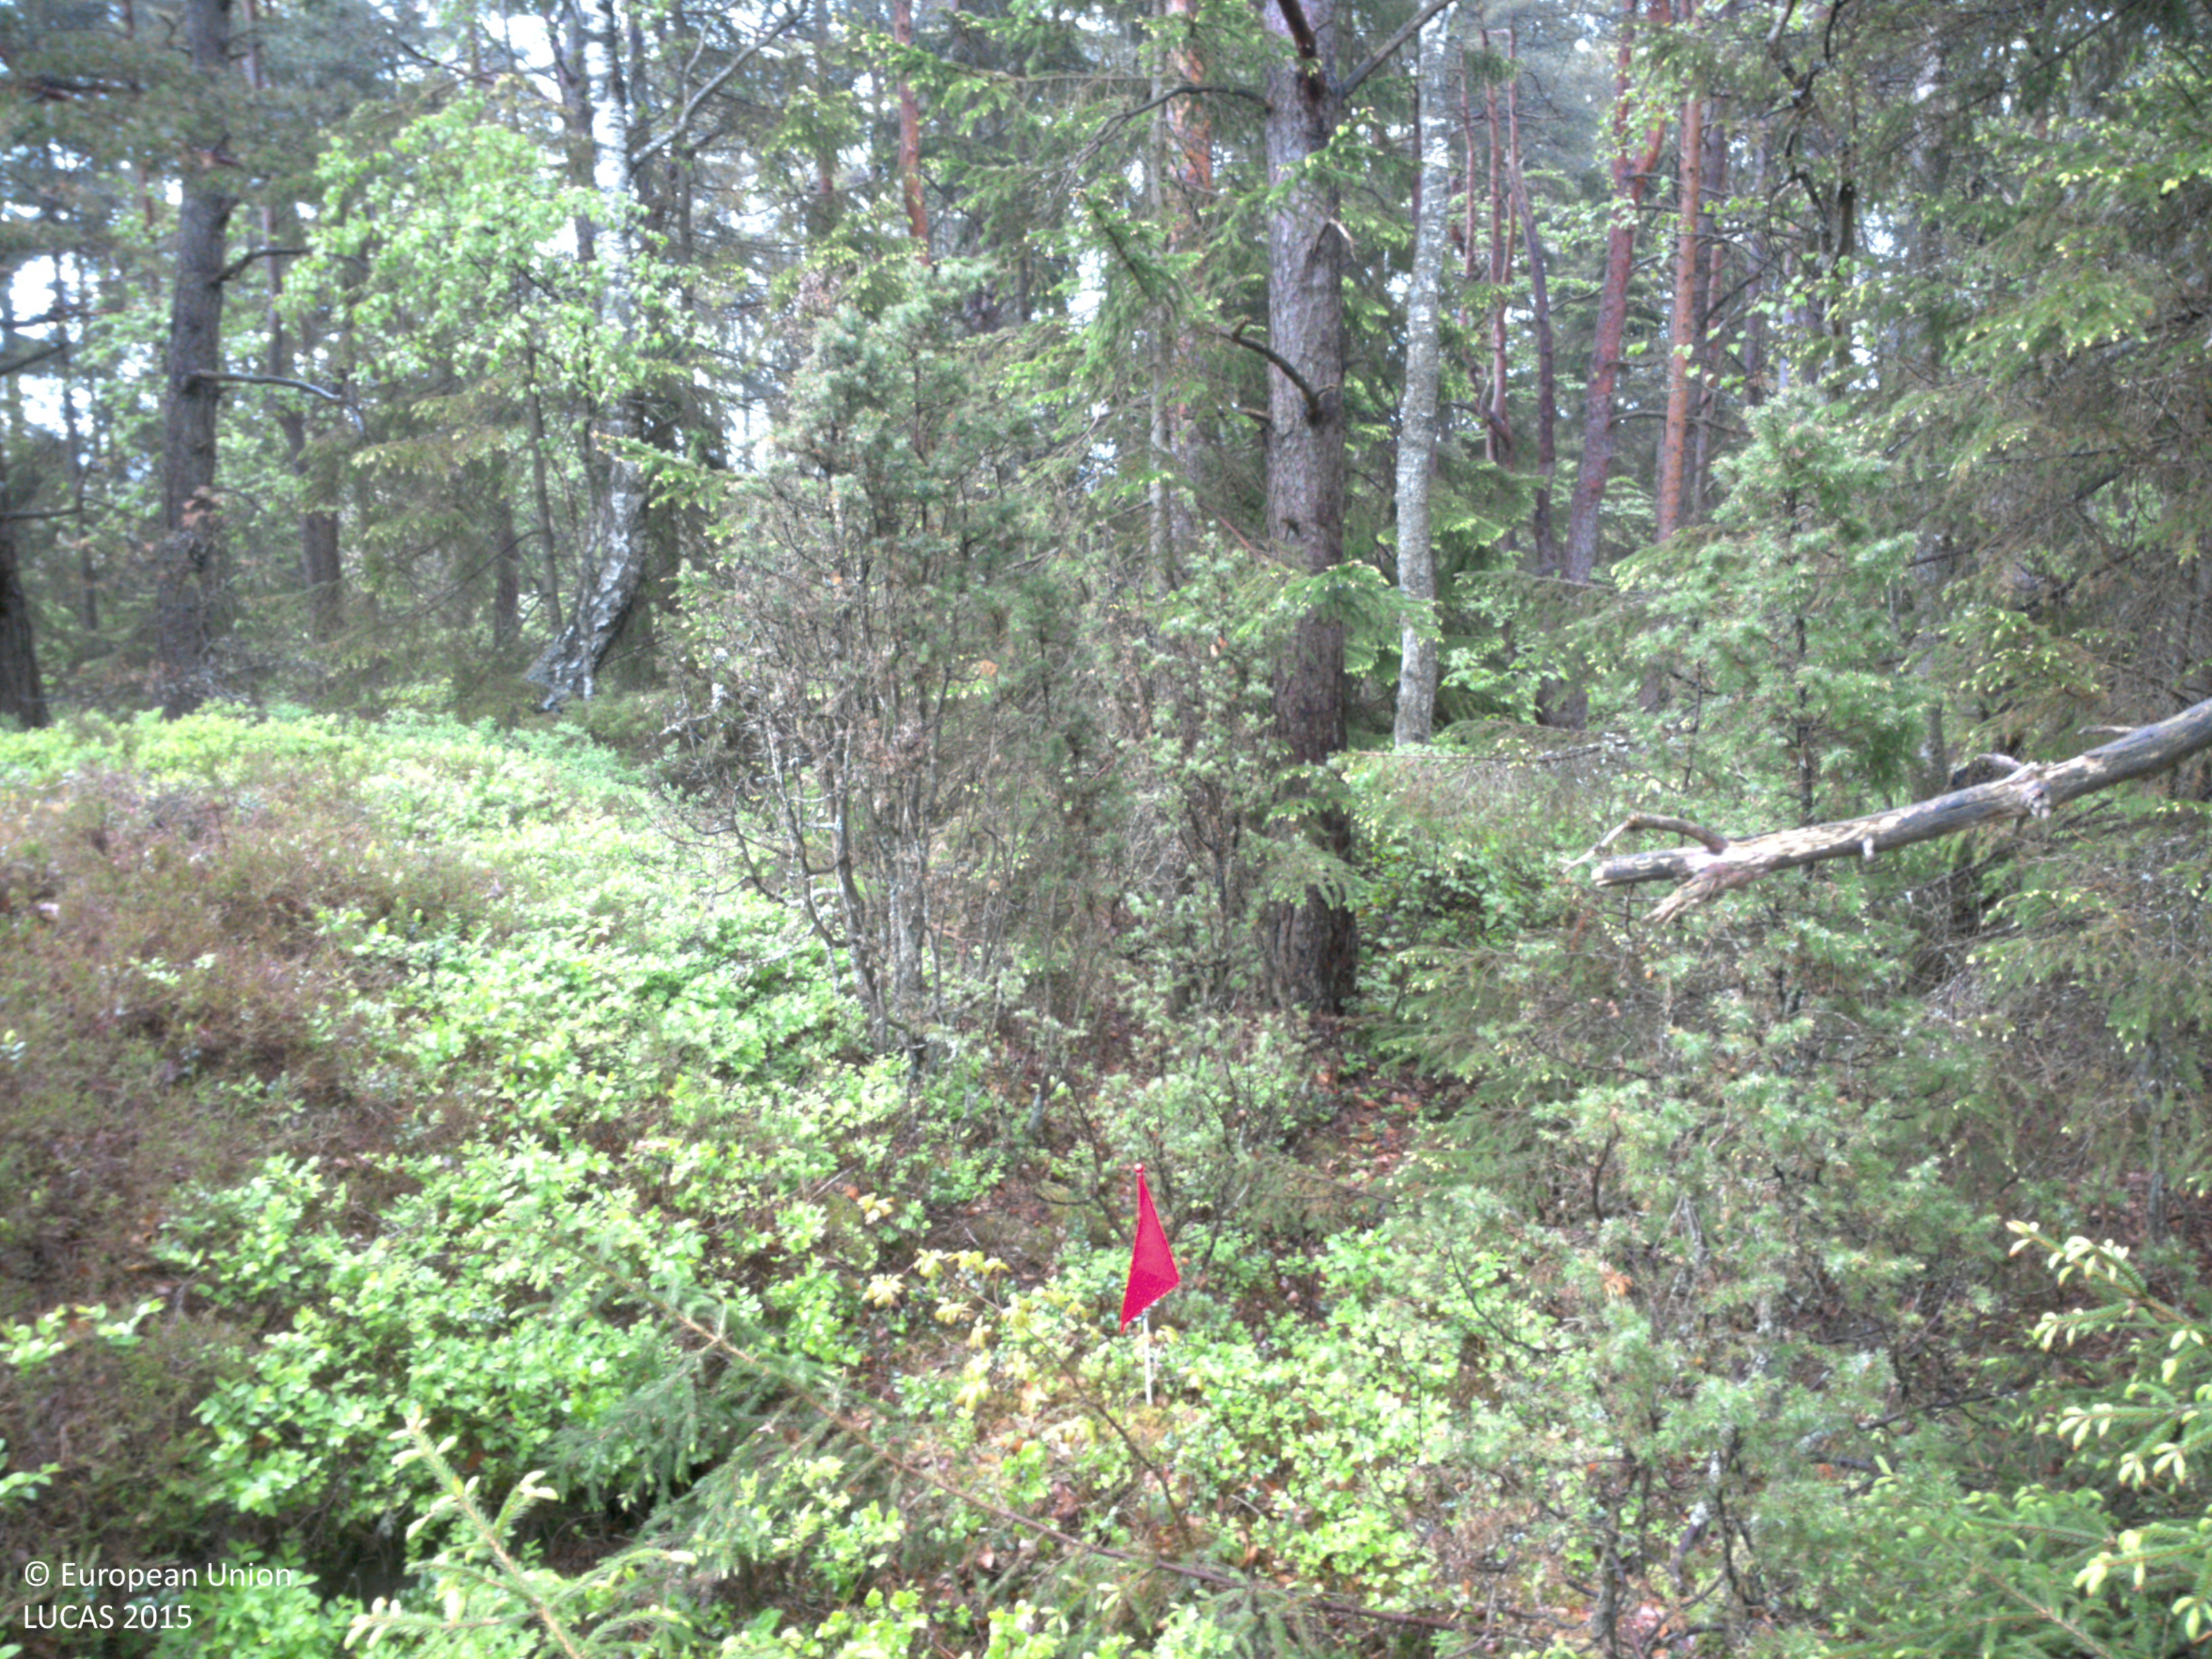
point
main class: Woodland
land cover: Spruce dominated mixed woodland
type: boreal forest
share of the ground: > 75 %
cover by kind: coniferous forest trees 60 %, broadleaved forest trees 30 %, herbaceous plants 10 %
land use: Forestry
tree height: > 5 m
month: May
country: SE
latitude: 58.3536
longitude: 11.6201
